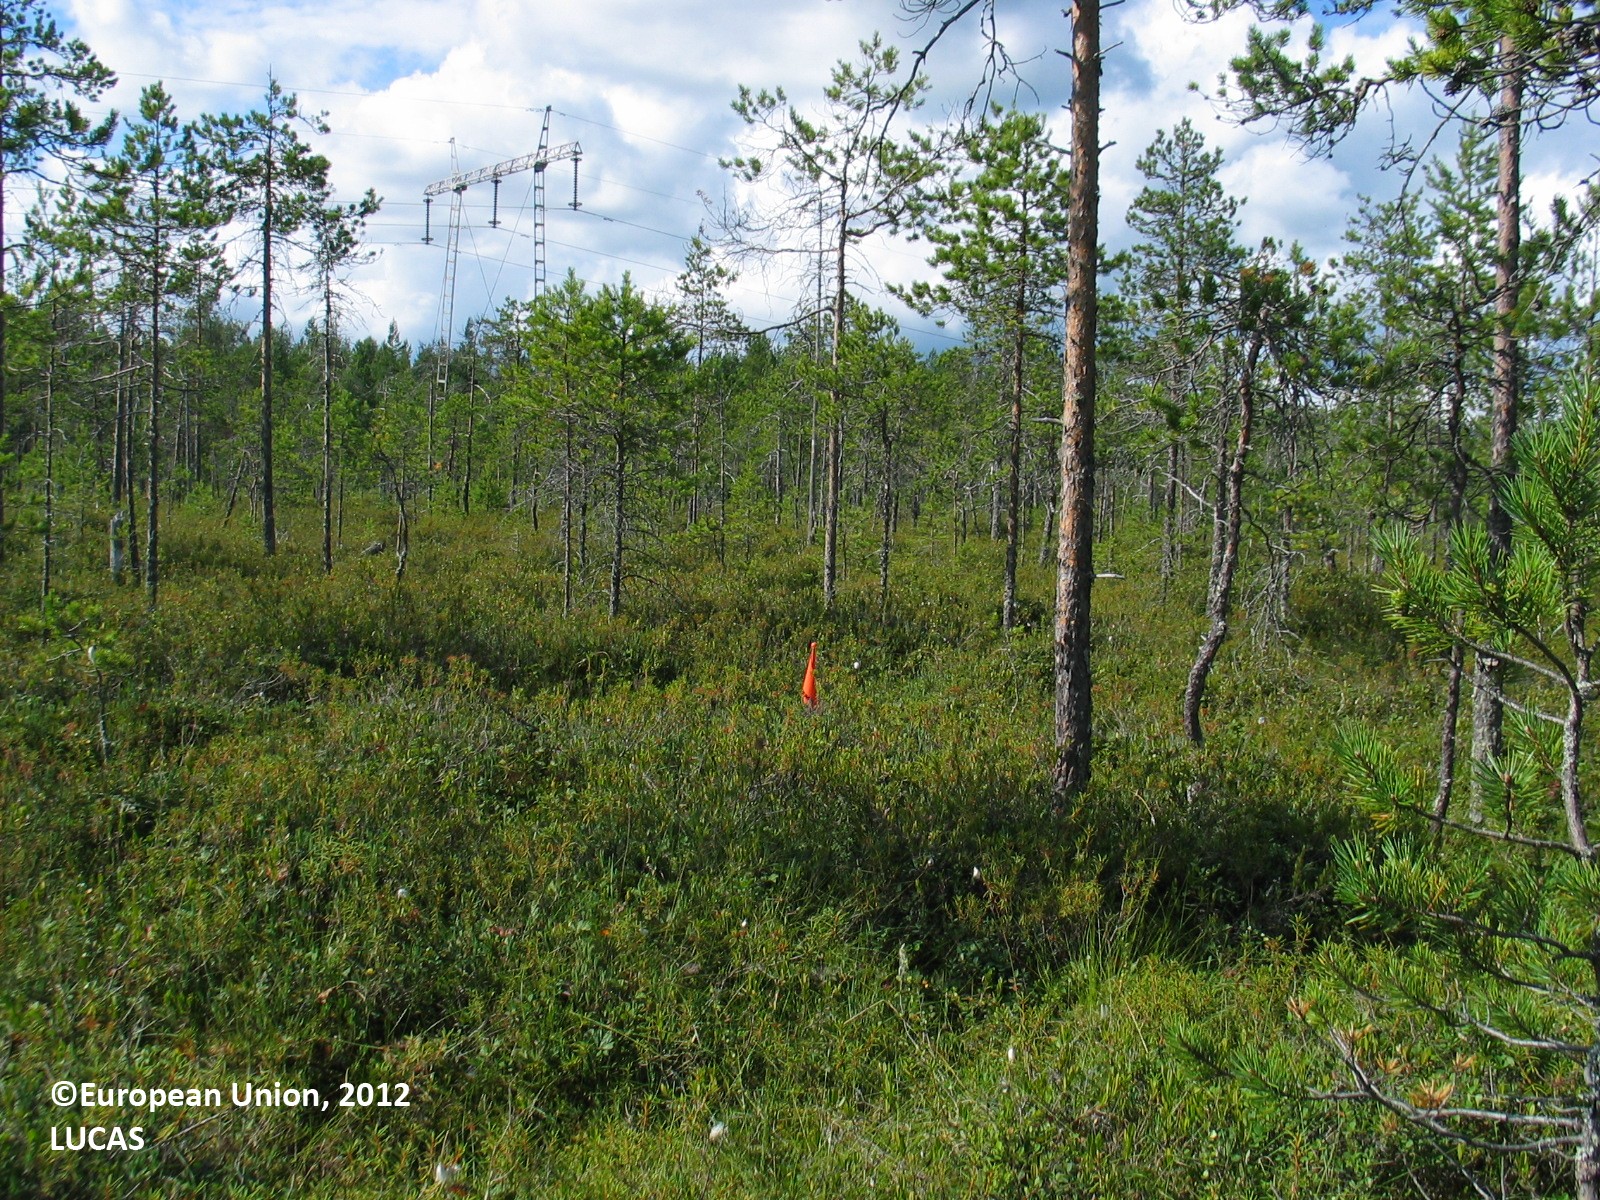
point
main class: Woodland
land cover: Pine dominated coniferous woodland
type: mire and swamp forests
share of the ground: 10 - 25 %
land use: Semi-natural and natural areas not in use
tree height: > 5 m
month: August
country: FI
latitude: 64.8026
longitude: 26.1643
